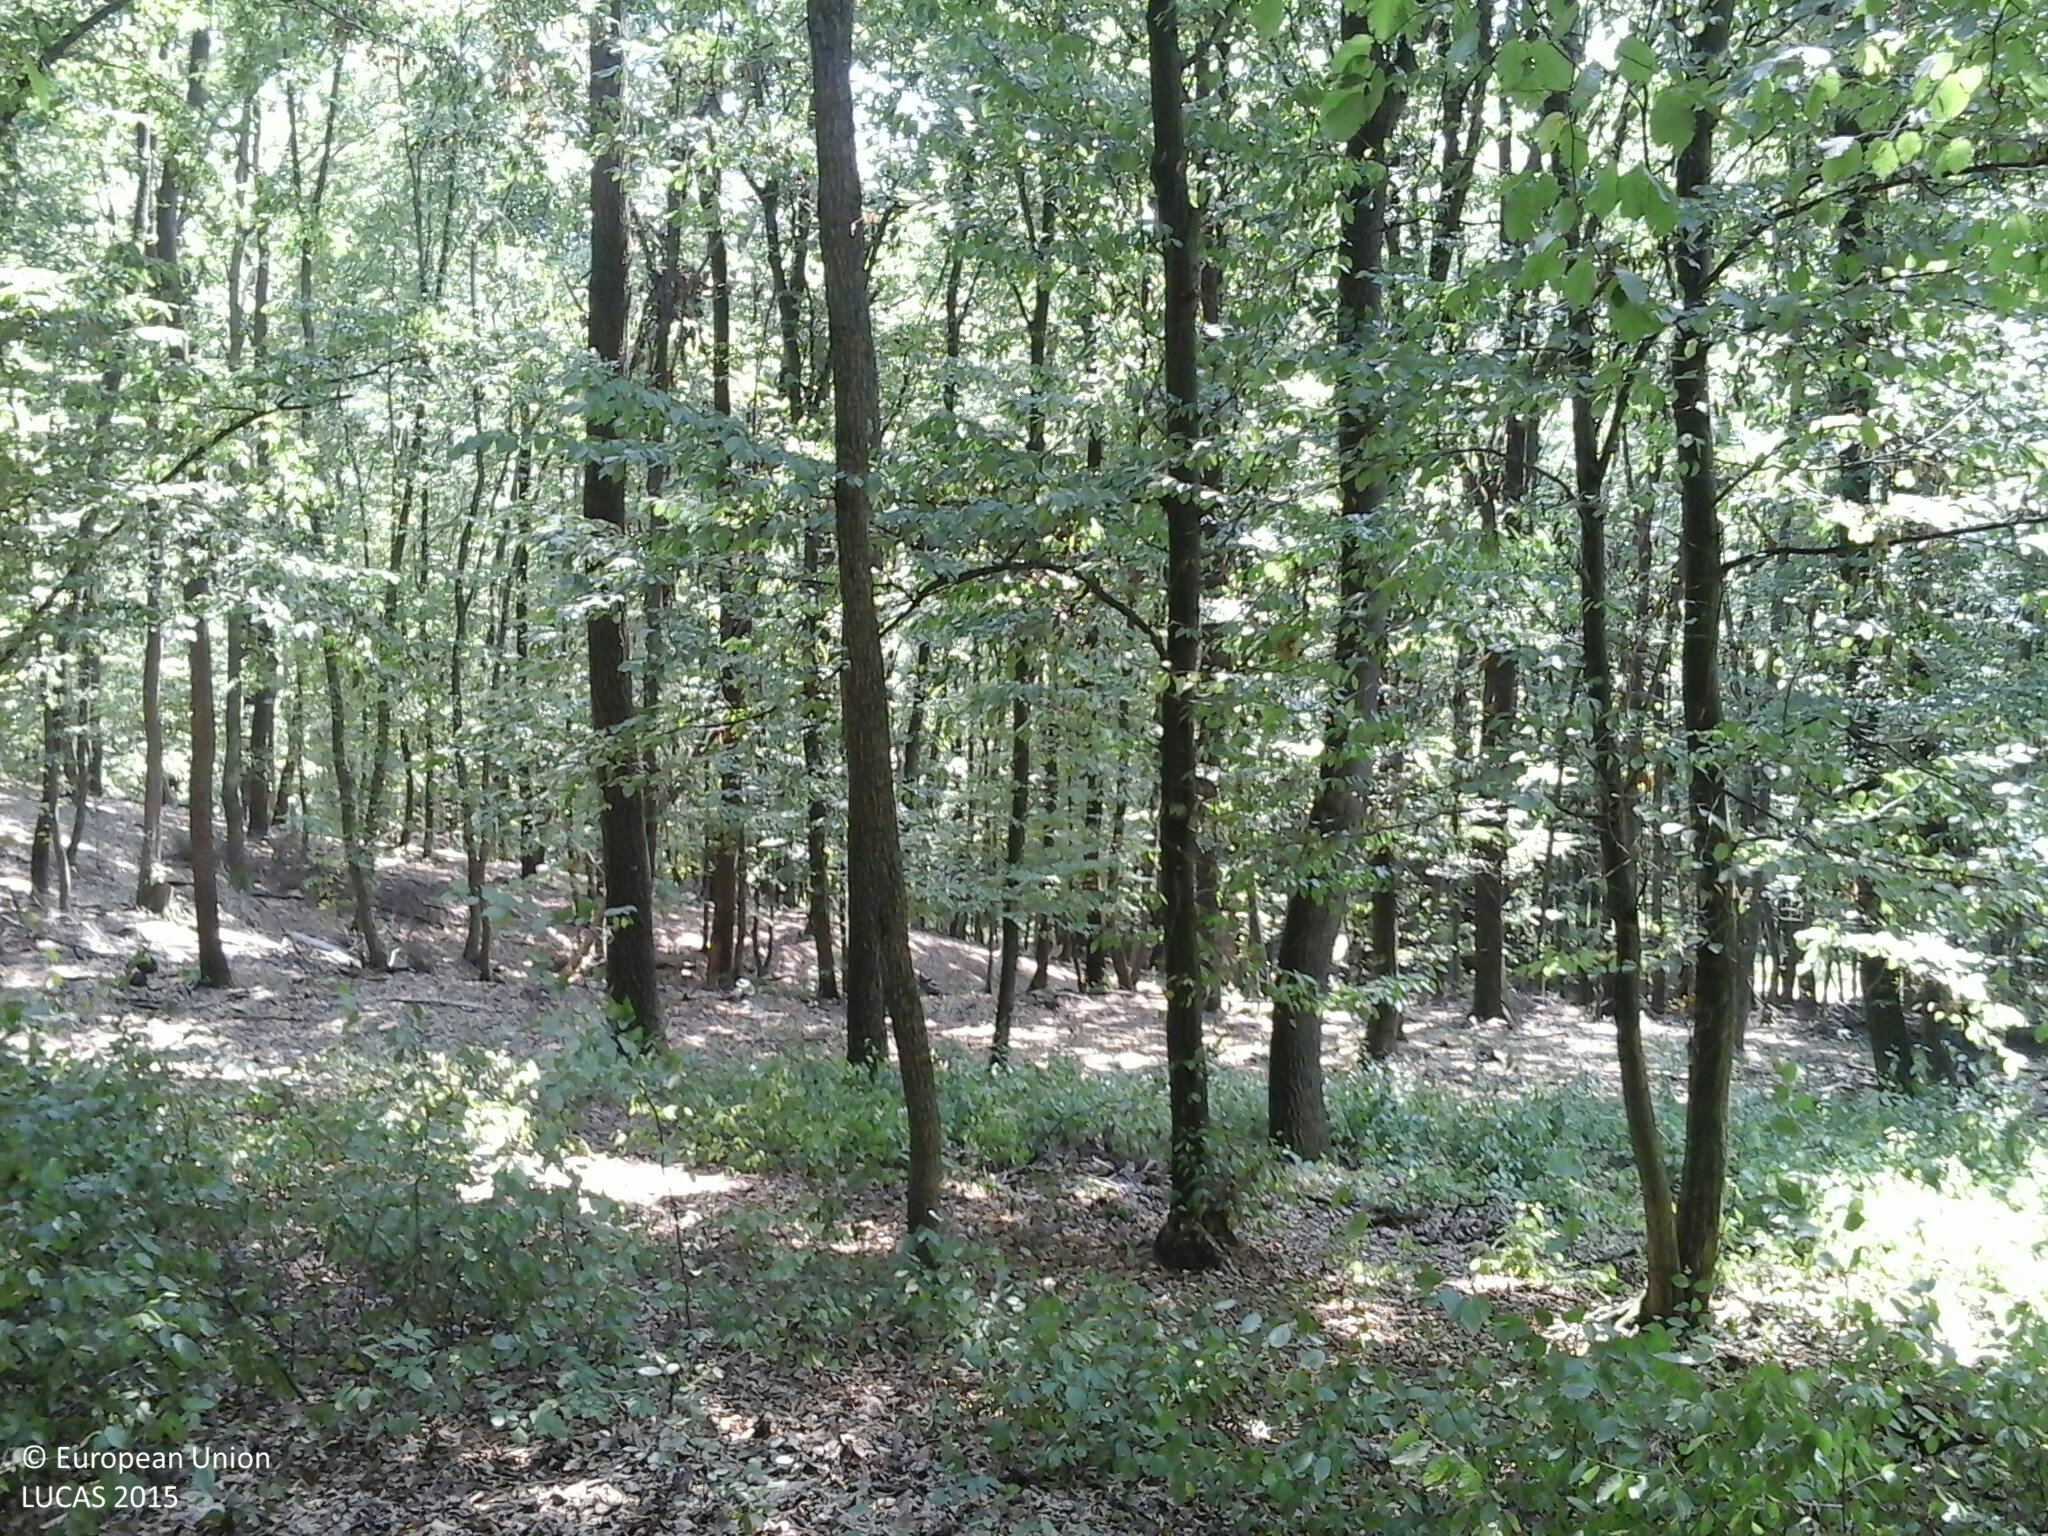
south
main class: Woodland
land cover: Broadleaved woodland
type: mesophytic deciduous forest
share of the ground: > 75 %
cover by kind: broadleaved forest trees 100 %
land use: Forestry
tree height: > 5 m
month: August
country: HU
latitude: 48.3208
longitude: 20.4860
